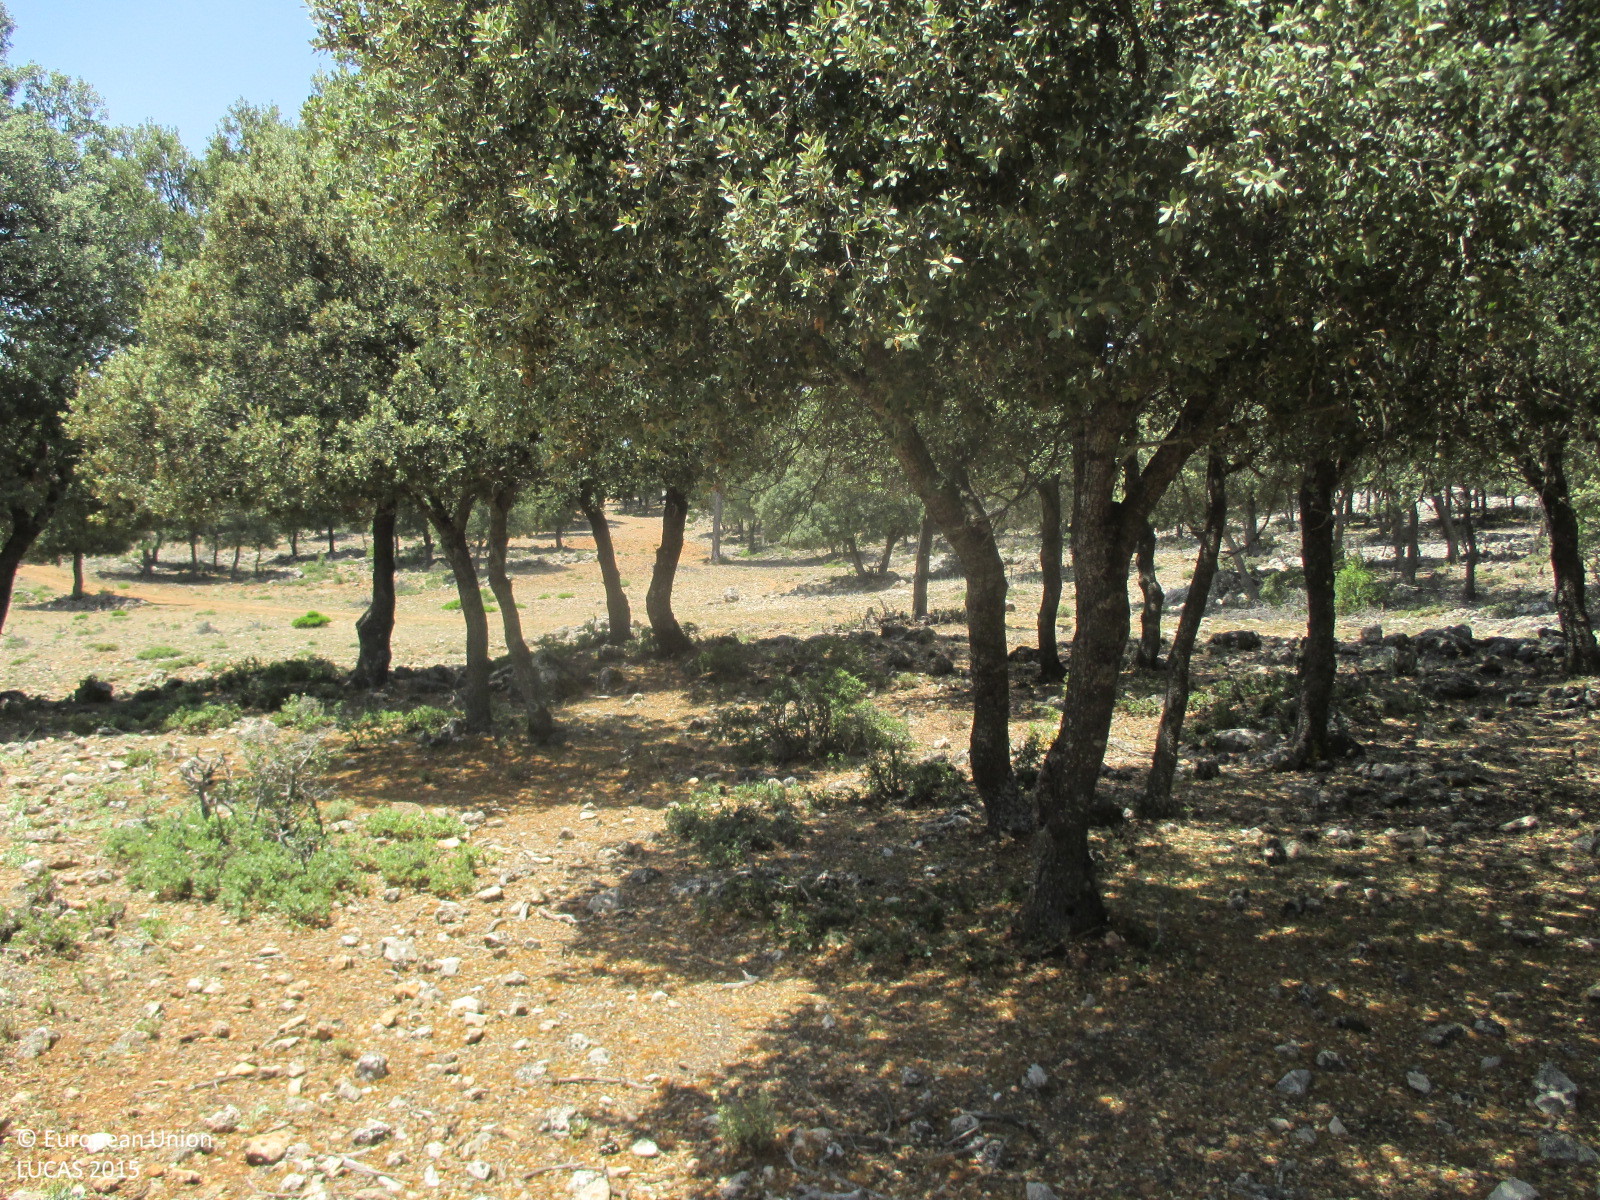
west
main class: Woodland
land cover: Broadleaved woodland
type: broadleaved evergreen forest
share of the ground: > 75 %
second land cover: Grassland without tree/shrub cover
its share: > 75 %
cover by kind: broadleaved forest trees 75 %, herbaceous plants 25 %
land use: Forestry
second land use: Agriculture (excluding fallow land and kitchen gardens)
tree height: > 5 m
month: July
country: ES
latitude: 38.0887
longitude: -2.5242
